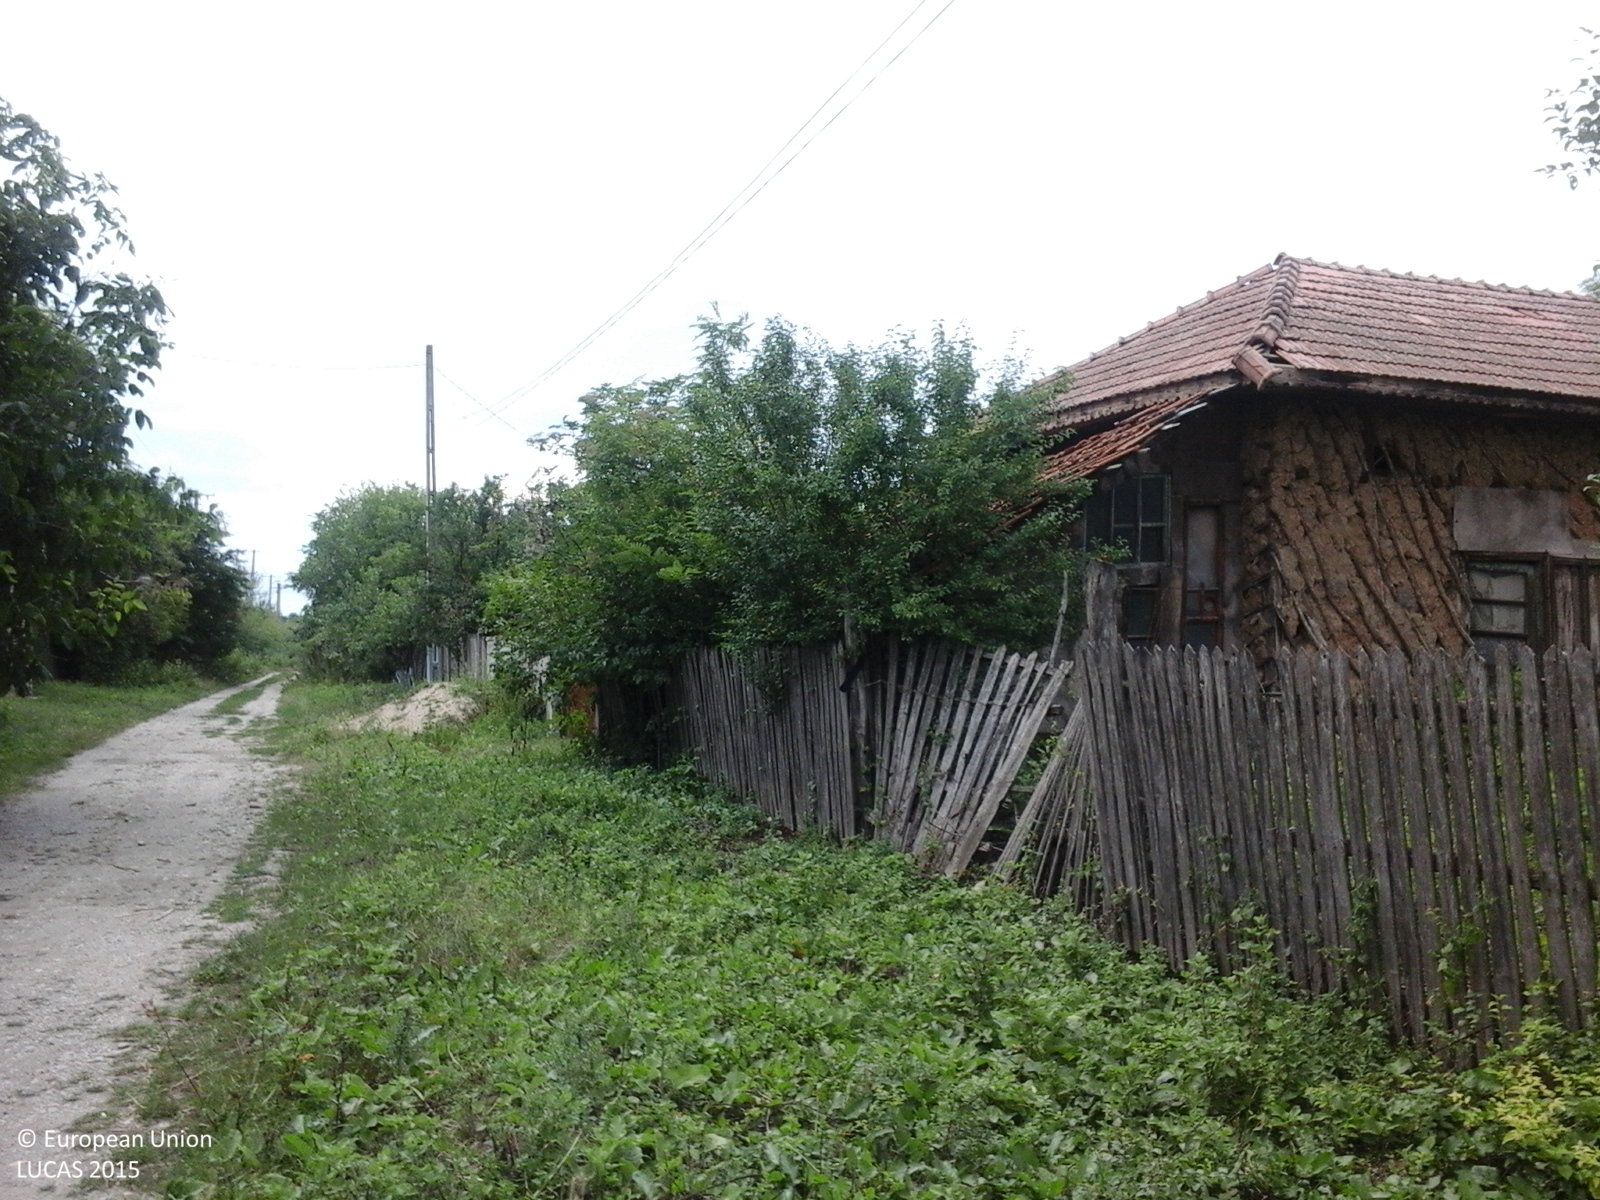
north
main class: Cropland
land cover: Other fresh vegetables
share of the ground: > 75 %
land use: Kitchen garden
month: July
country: RO
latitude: 44.1060
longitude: 24.8027
